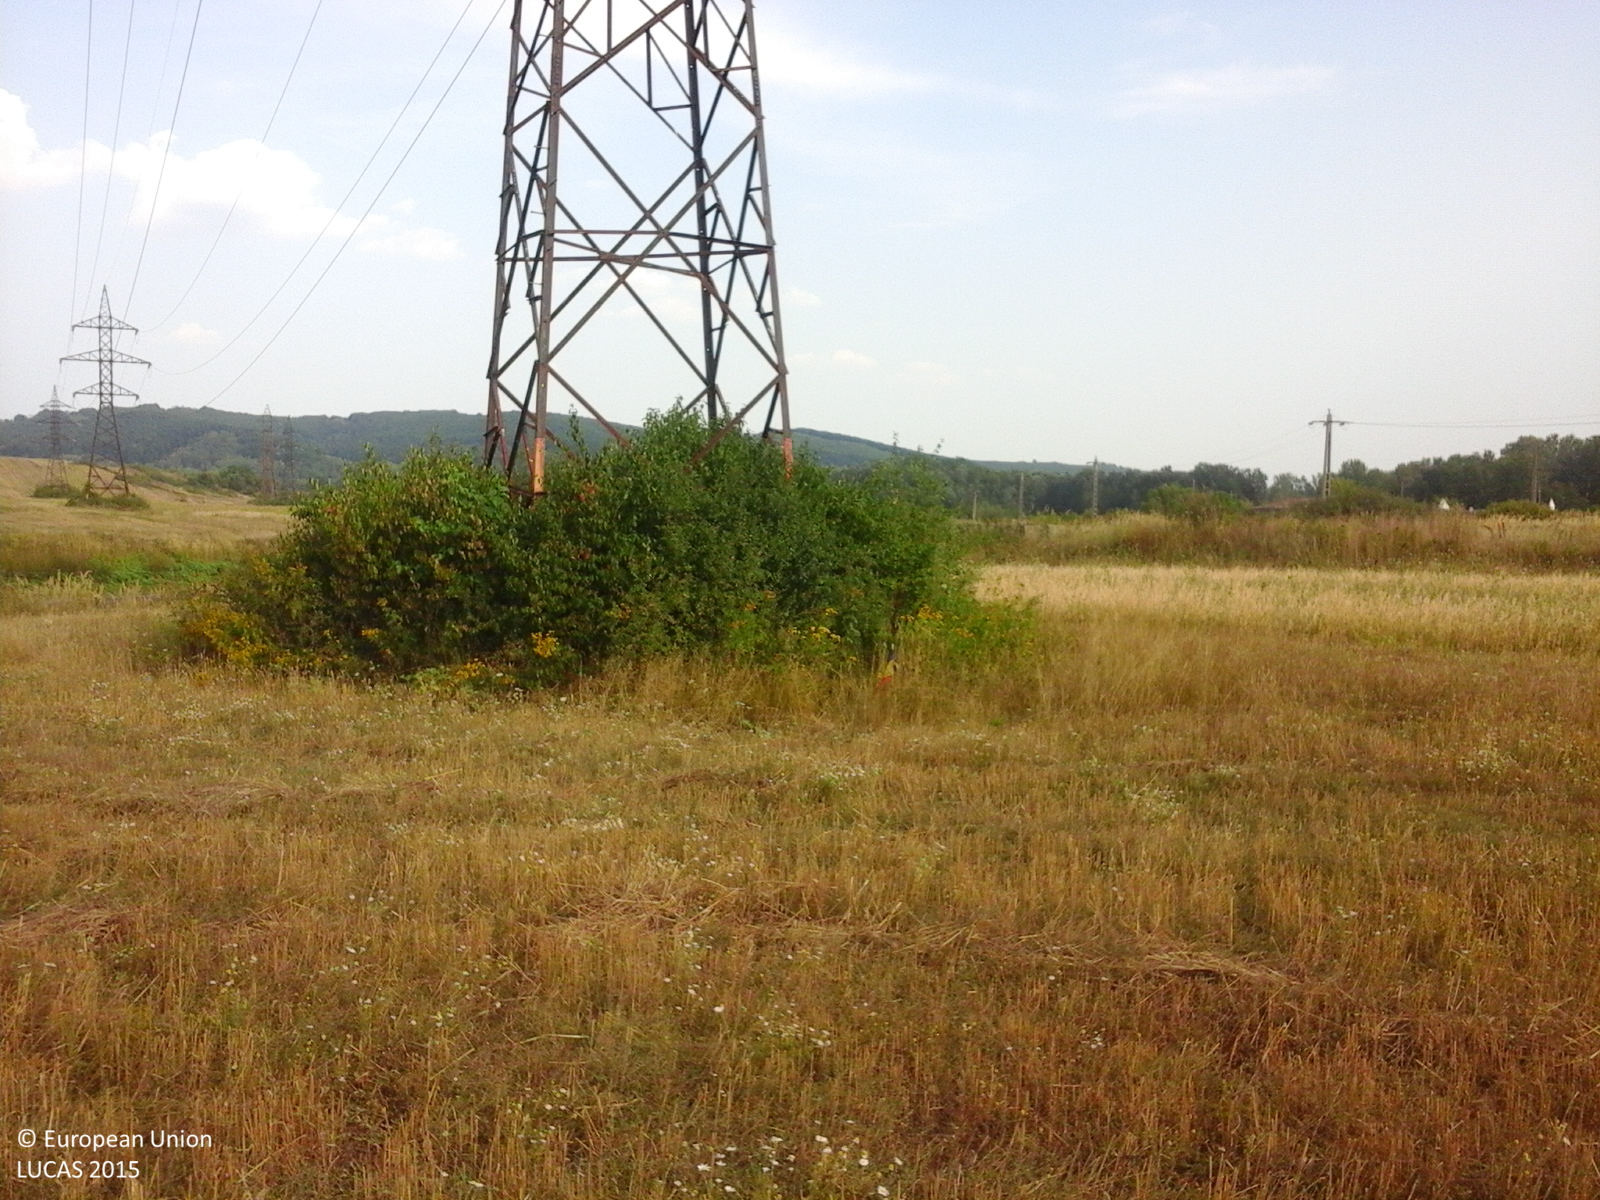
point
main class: Cropland
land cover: Common wheat
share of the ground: > 75 %
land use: Agriculture (excluding fallow land and kitchen gardens)
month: August
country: RO
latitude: 44.7252
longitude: 23.6299
